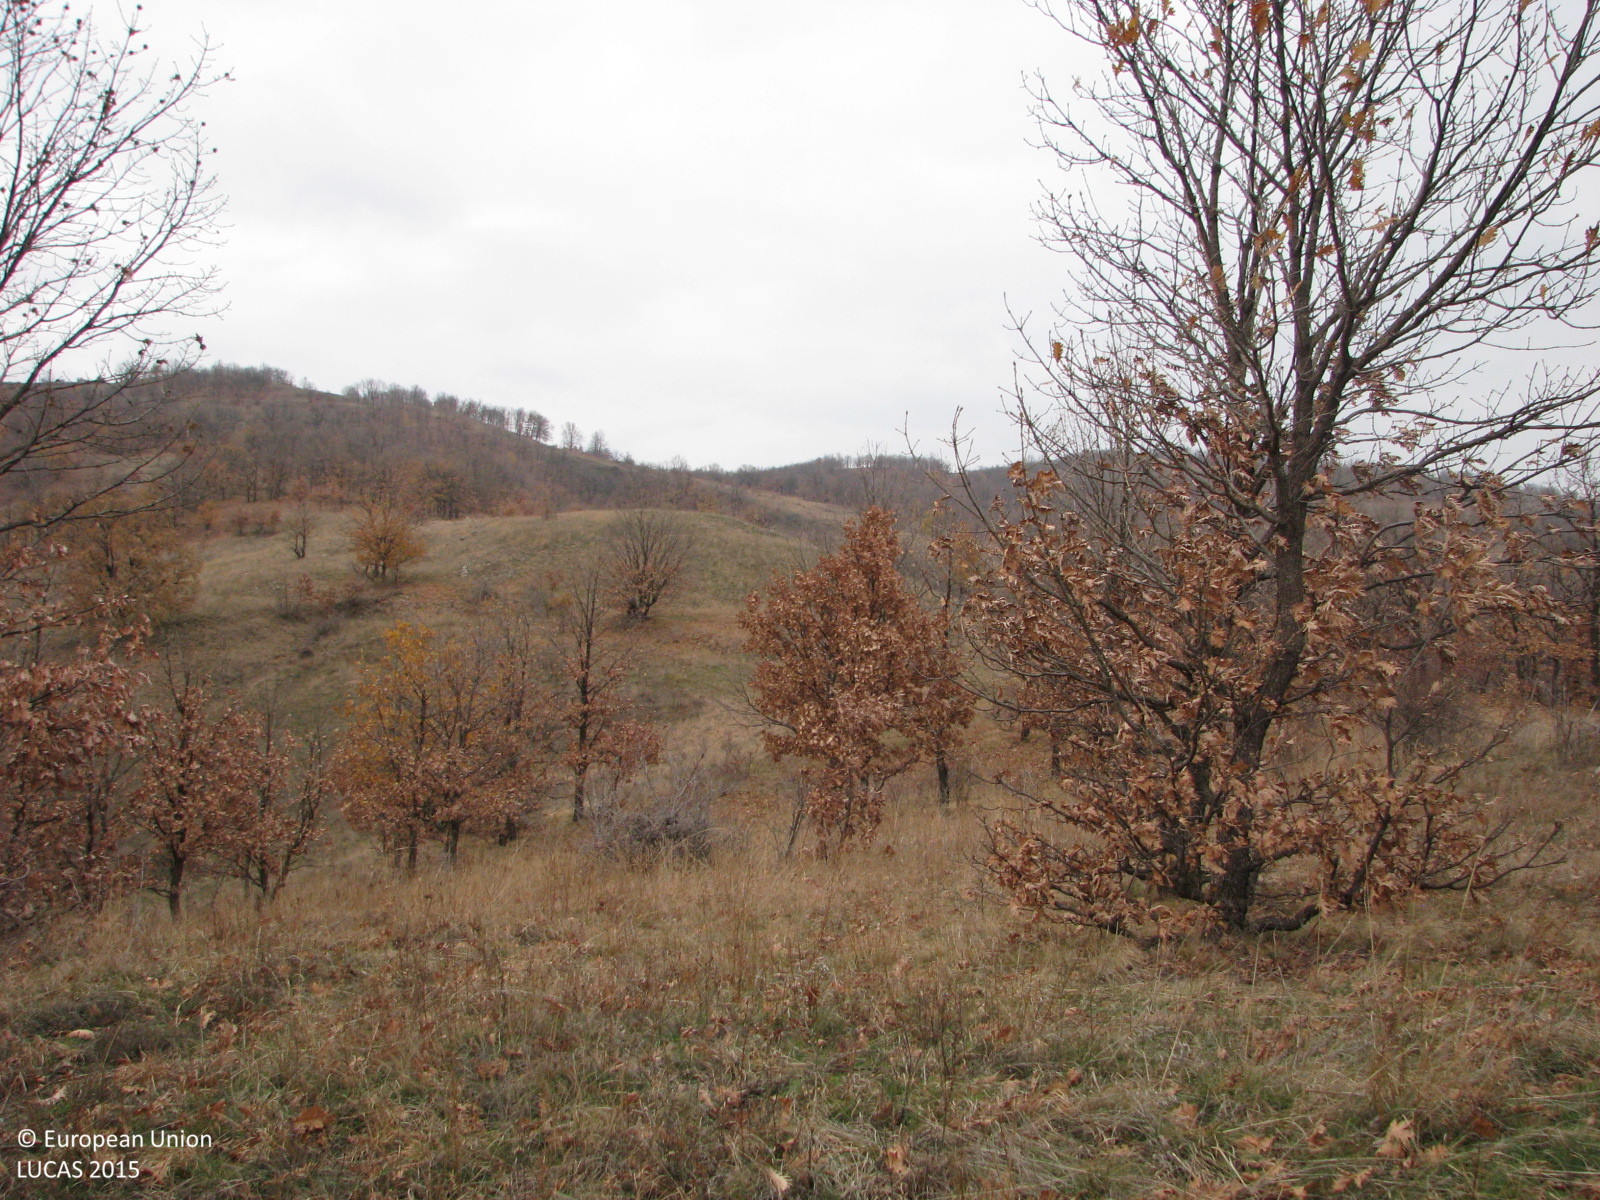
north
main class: Grassland
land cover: Grassland with sparse tree/shrub cover
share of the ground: > 75 %
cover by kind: herbaceous plants 90 %, broadleaved forest trees 5 %, shrubs 5 %
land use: Agriculture (excluding fallow land and kitchen gardens)
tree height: < 5 m
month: December
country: BG
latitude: 42.3514
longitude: 24.0142
